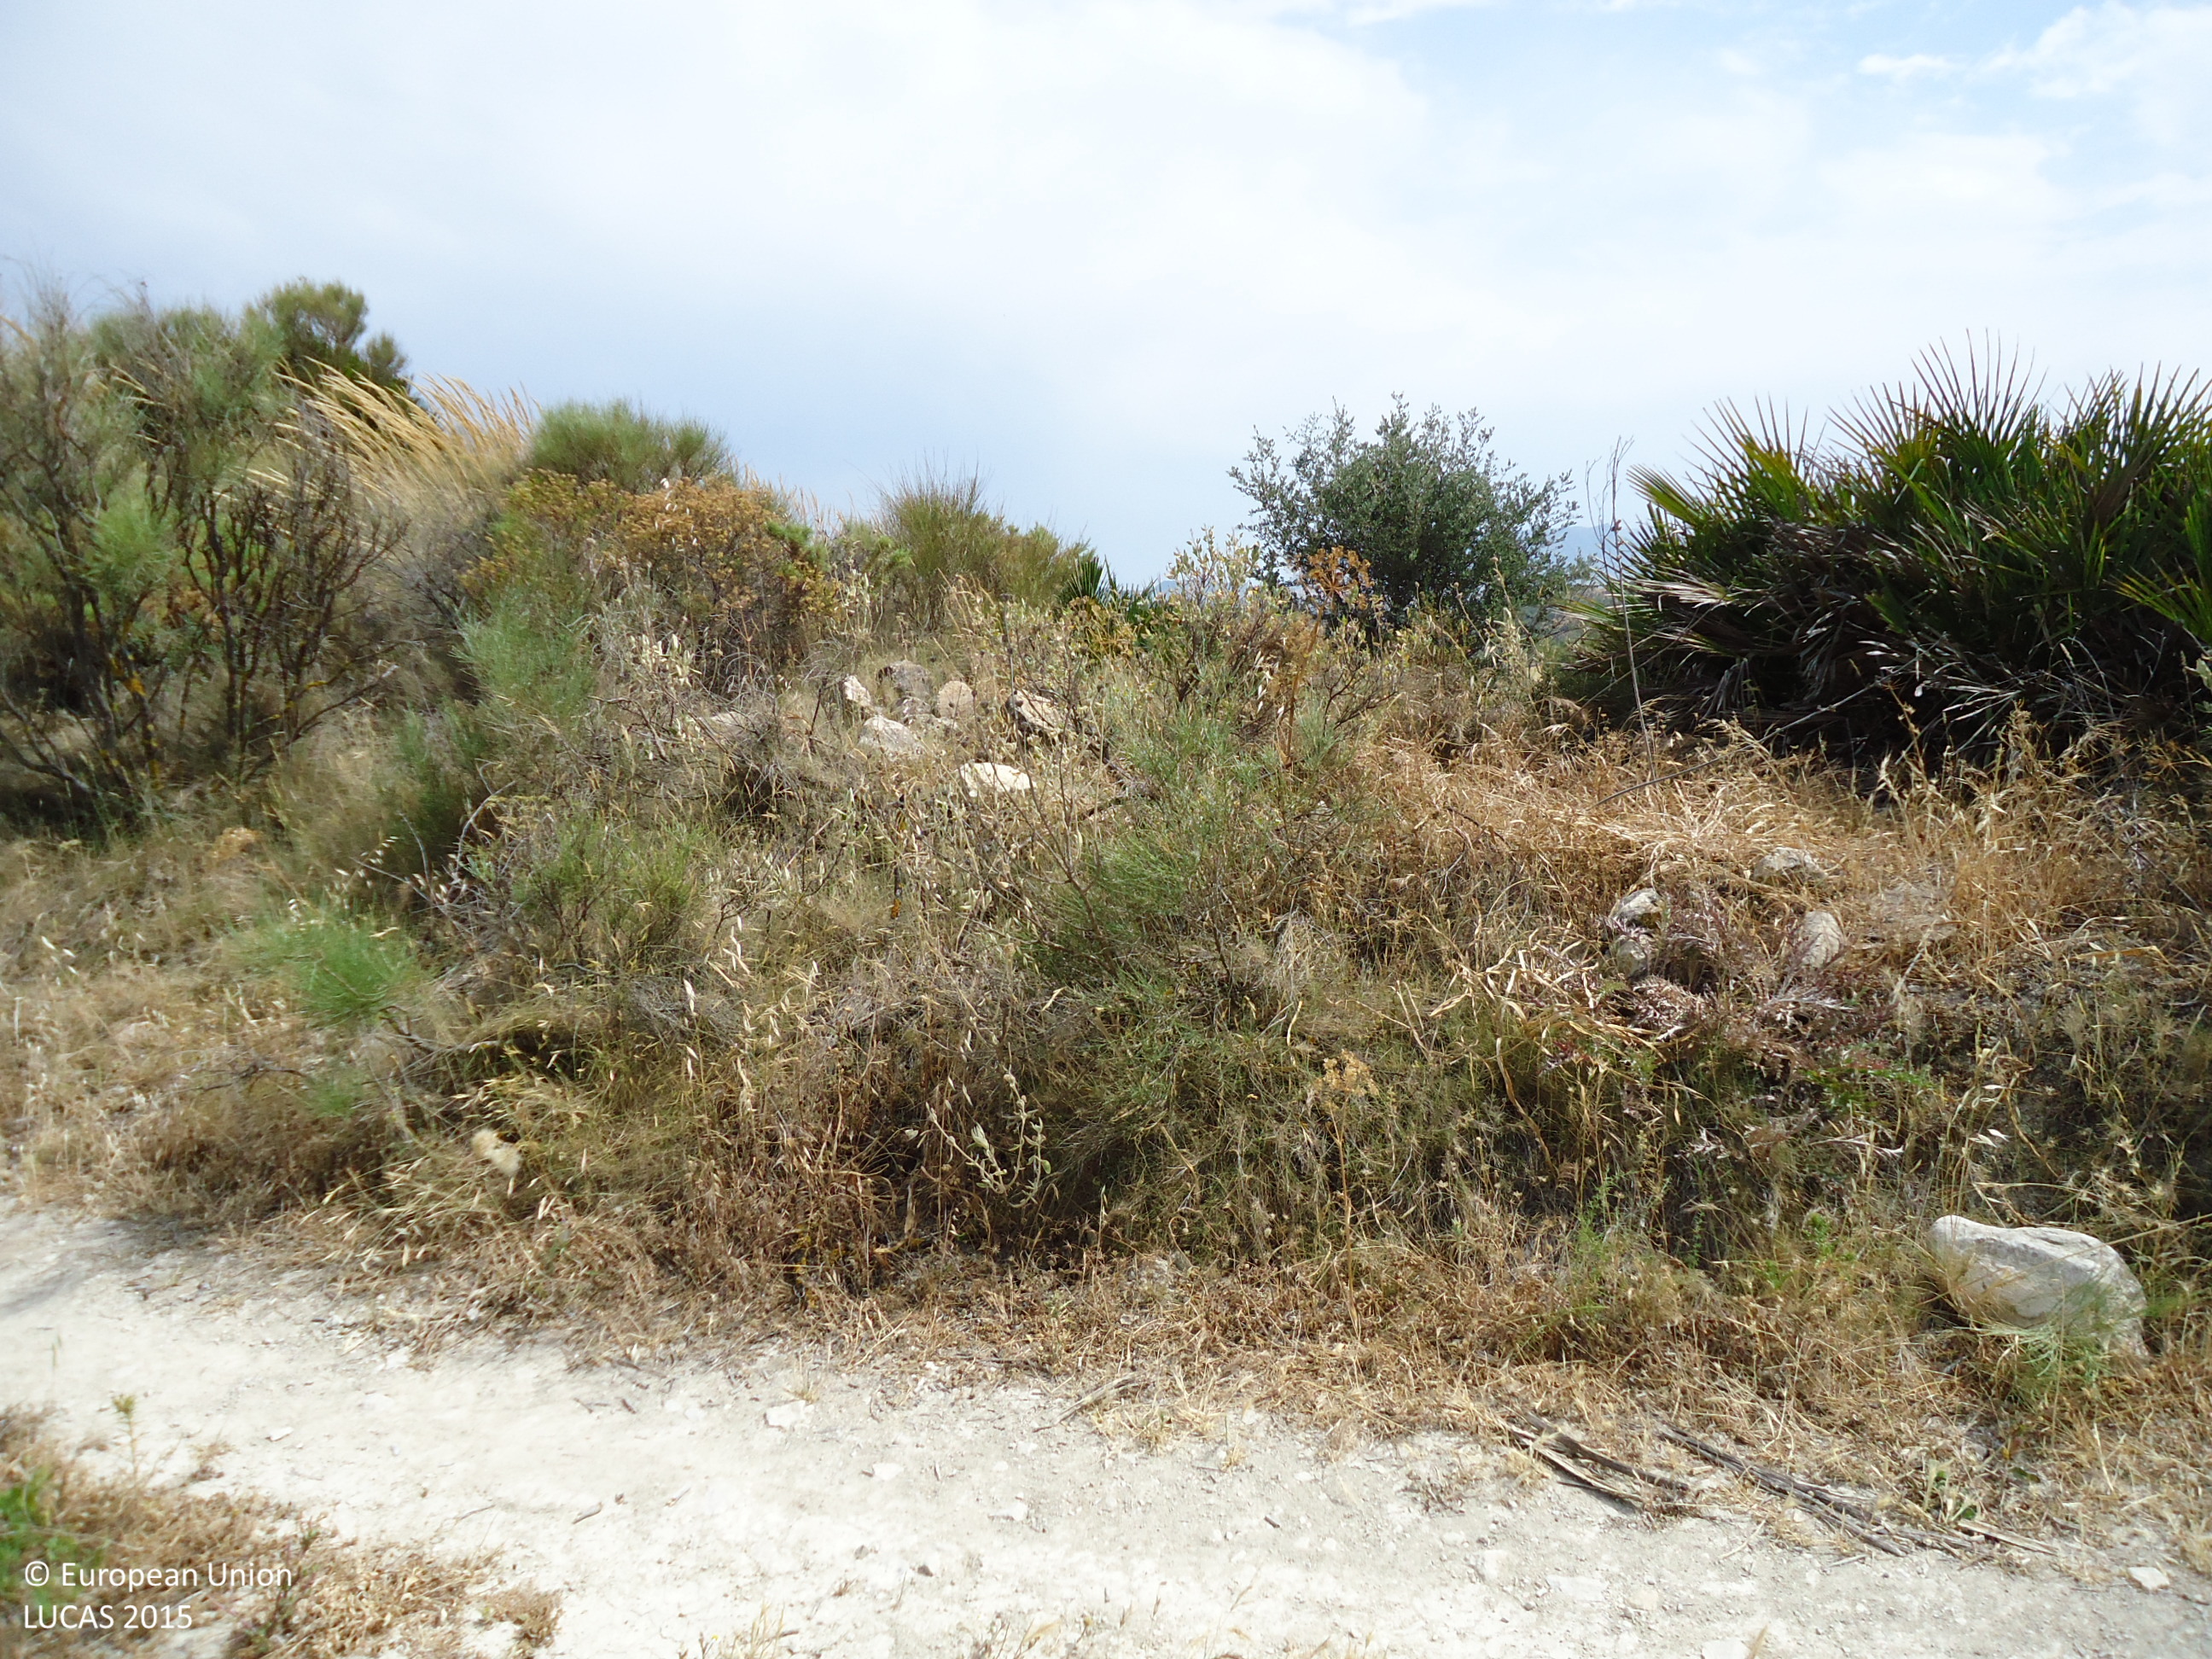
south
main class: Cropland
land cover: Olive groves
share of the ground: 25 - 50 %
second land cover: Other bare soil
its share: > 75 %
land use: Agriculture (excluding fallow land and kitchen gardens)
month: June
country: ES
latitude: 36.9845
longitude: -4.8178
